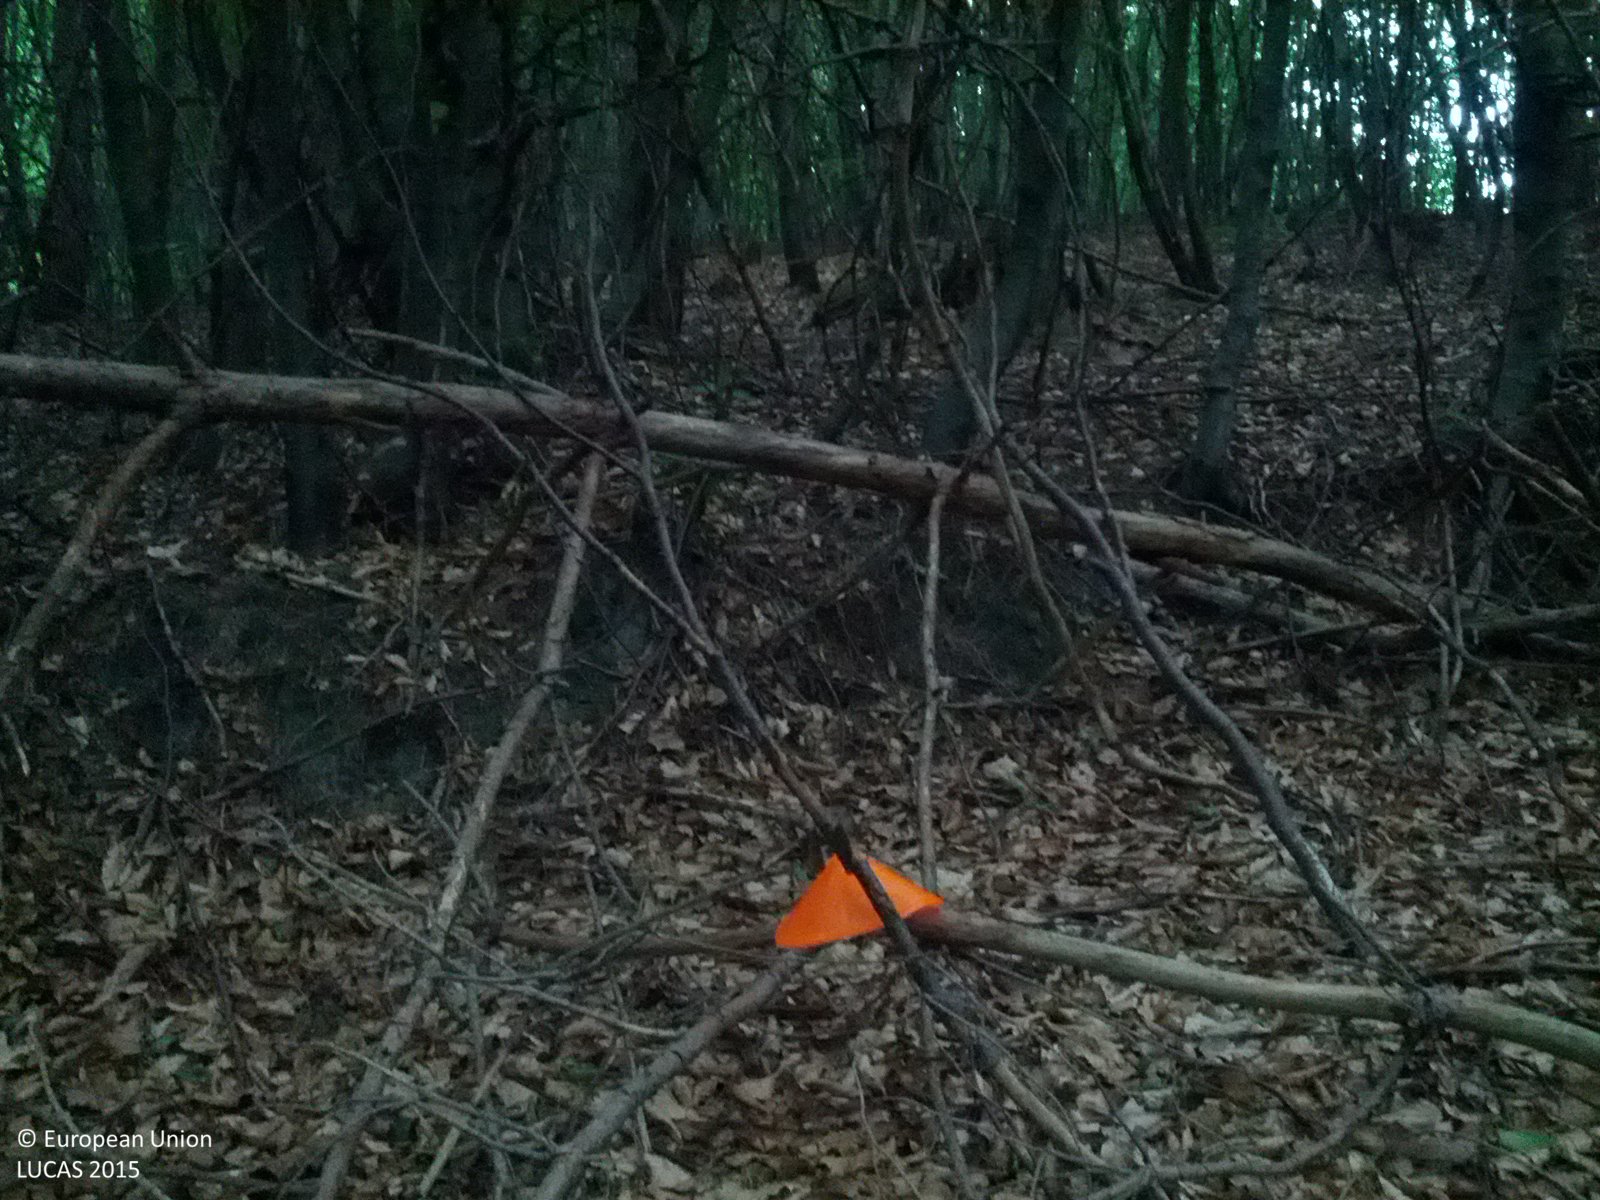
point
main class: Woodland
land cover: Broadleaved woodland
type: beech forest
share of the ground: > 75 %
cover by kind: broadleaved forest trees 100 %
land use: Forestry
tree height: > 5 m
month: June
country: AT
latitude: 48.2170
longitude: 16.1010
